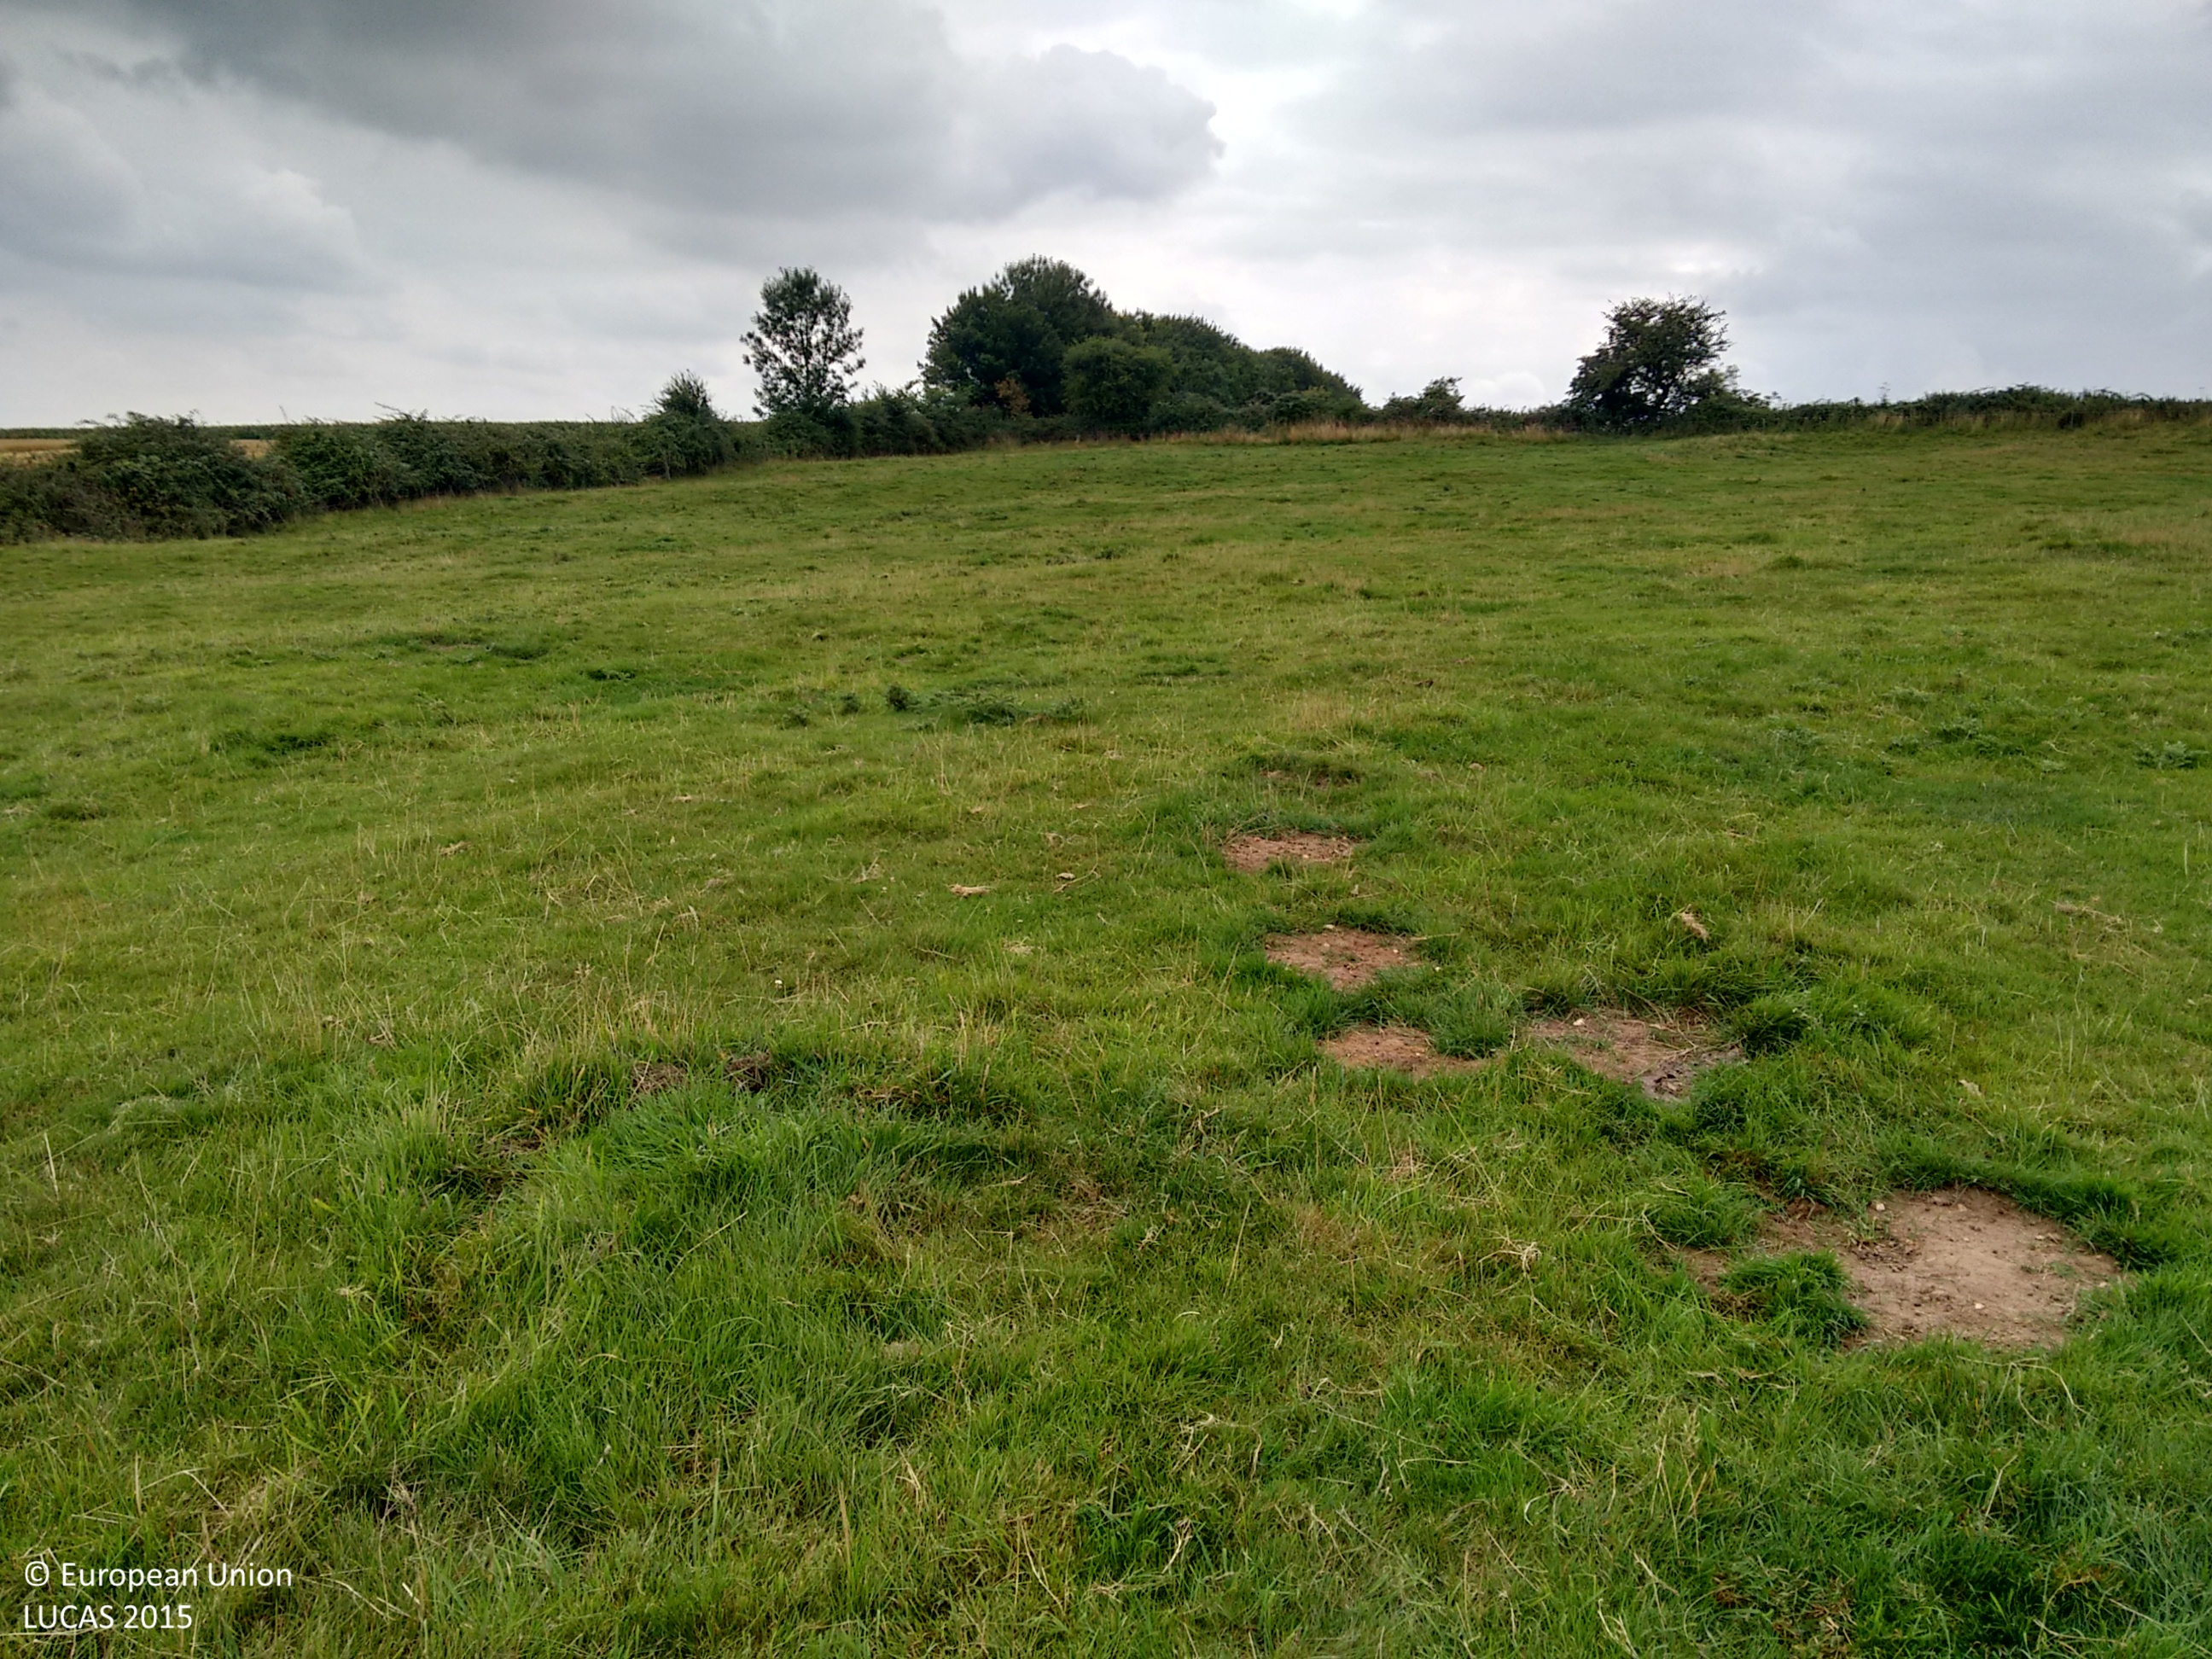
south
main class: Grassland
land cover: Grassland without tree/shrub cover
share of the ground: > 75 %
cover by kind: herbaceous plants 100 %
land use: Agriculture (excluding fallow land and kitchen gardens)
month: August
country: GB
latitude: 52.6450
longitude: 0.4690
